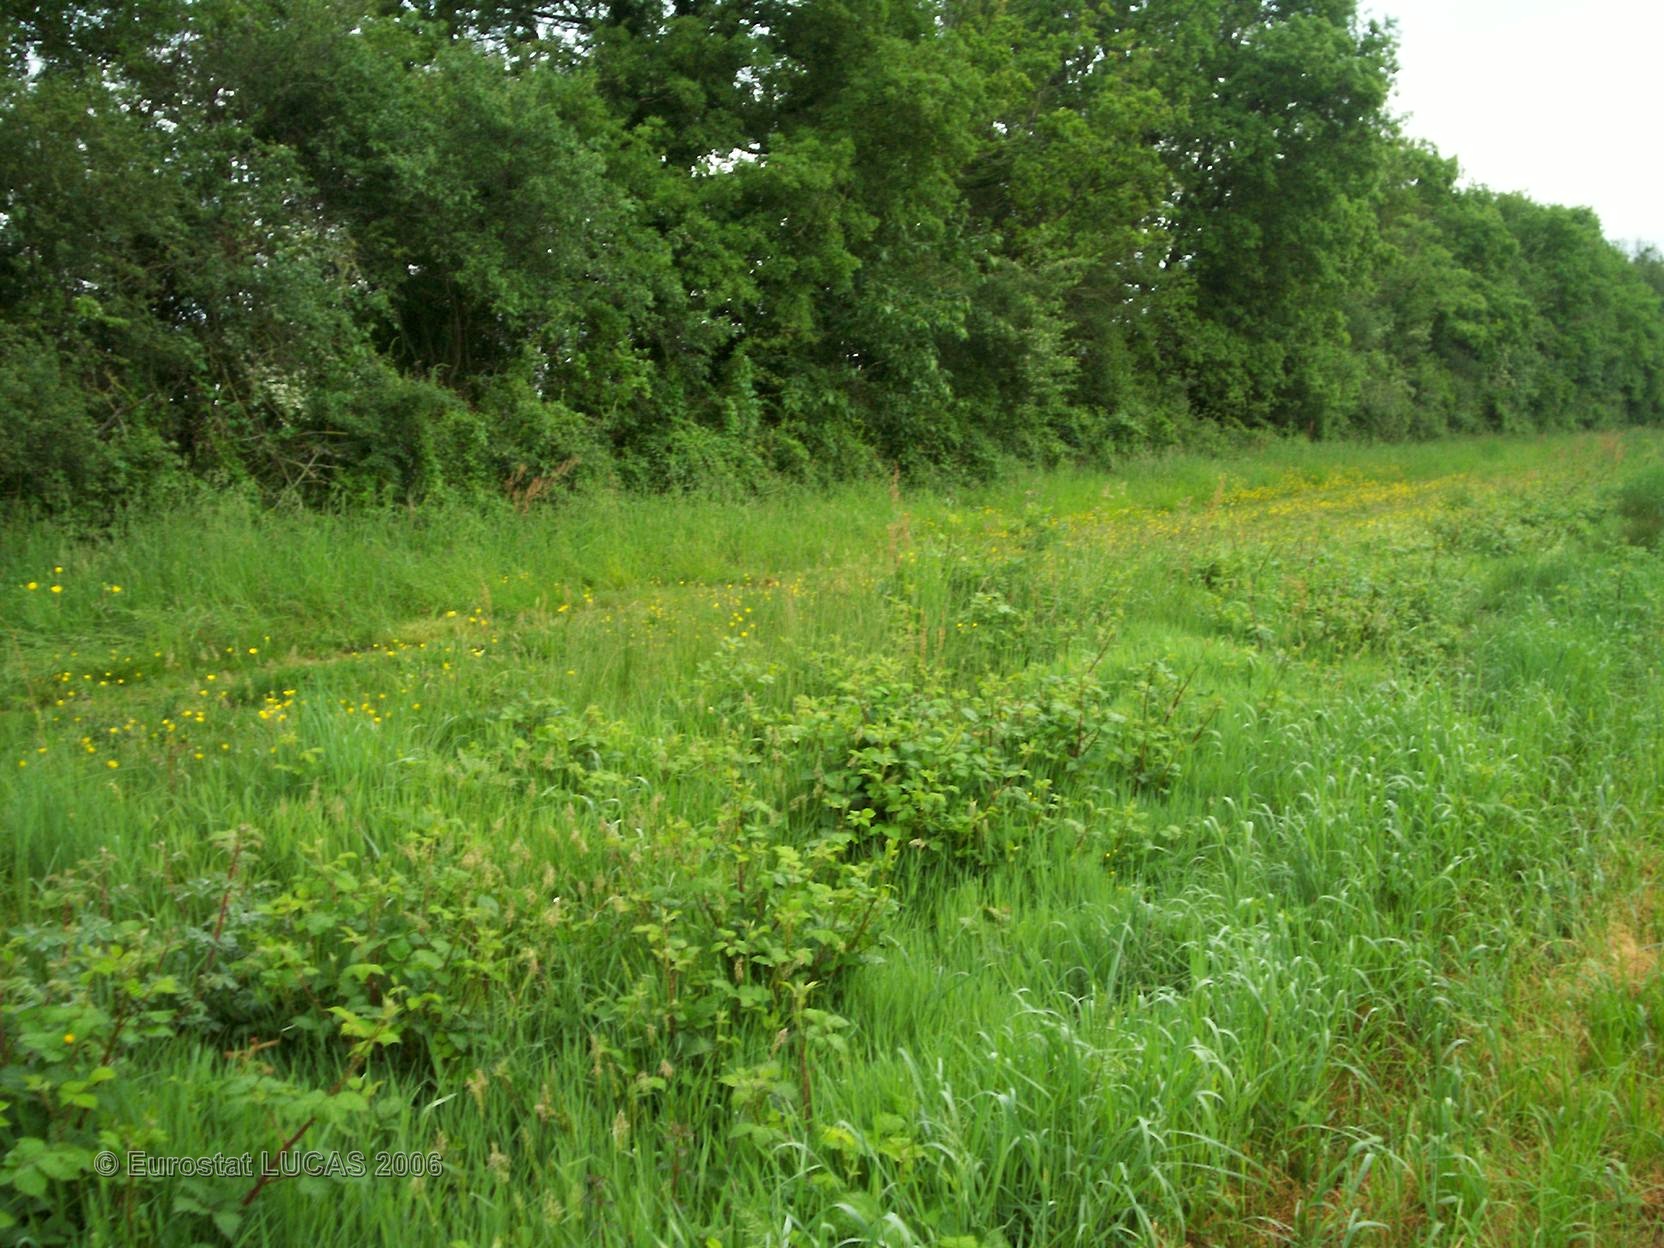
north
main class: Grassland
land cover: Grassland without tree/shrub cover
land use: Agriculture (excluding fallow land and kitchen gardens)
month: May
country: FR
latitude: 46.8945
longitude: 0.9939
